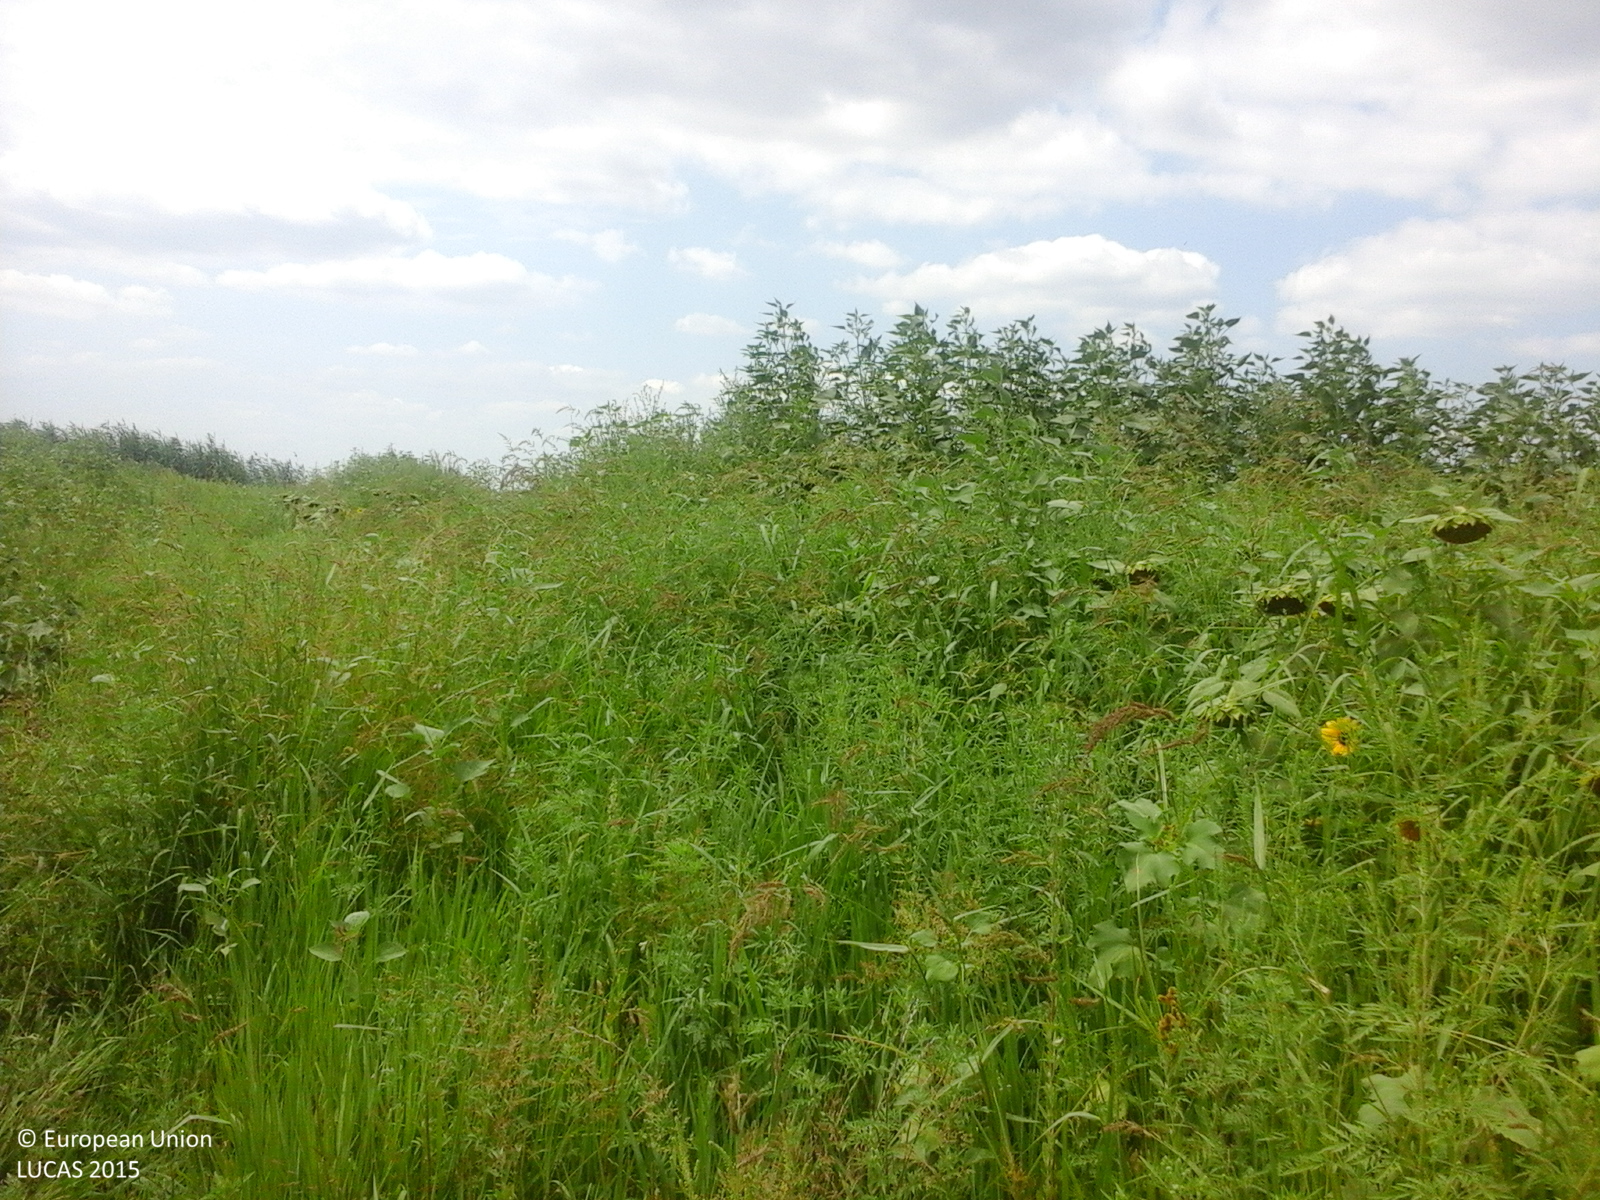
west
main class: Cropland
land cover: Sunflower
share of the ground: > 75 %
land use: Agriculture (excluding fallow land and kitchen gardens)
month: August
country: RO
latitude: 45.2779
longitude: 29.0820
